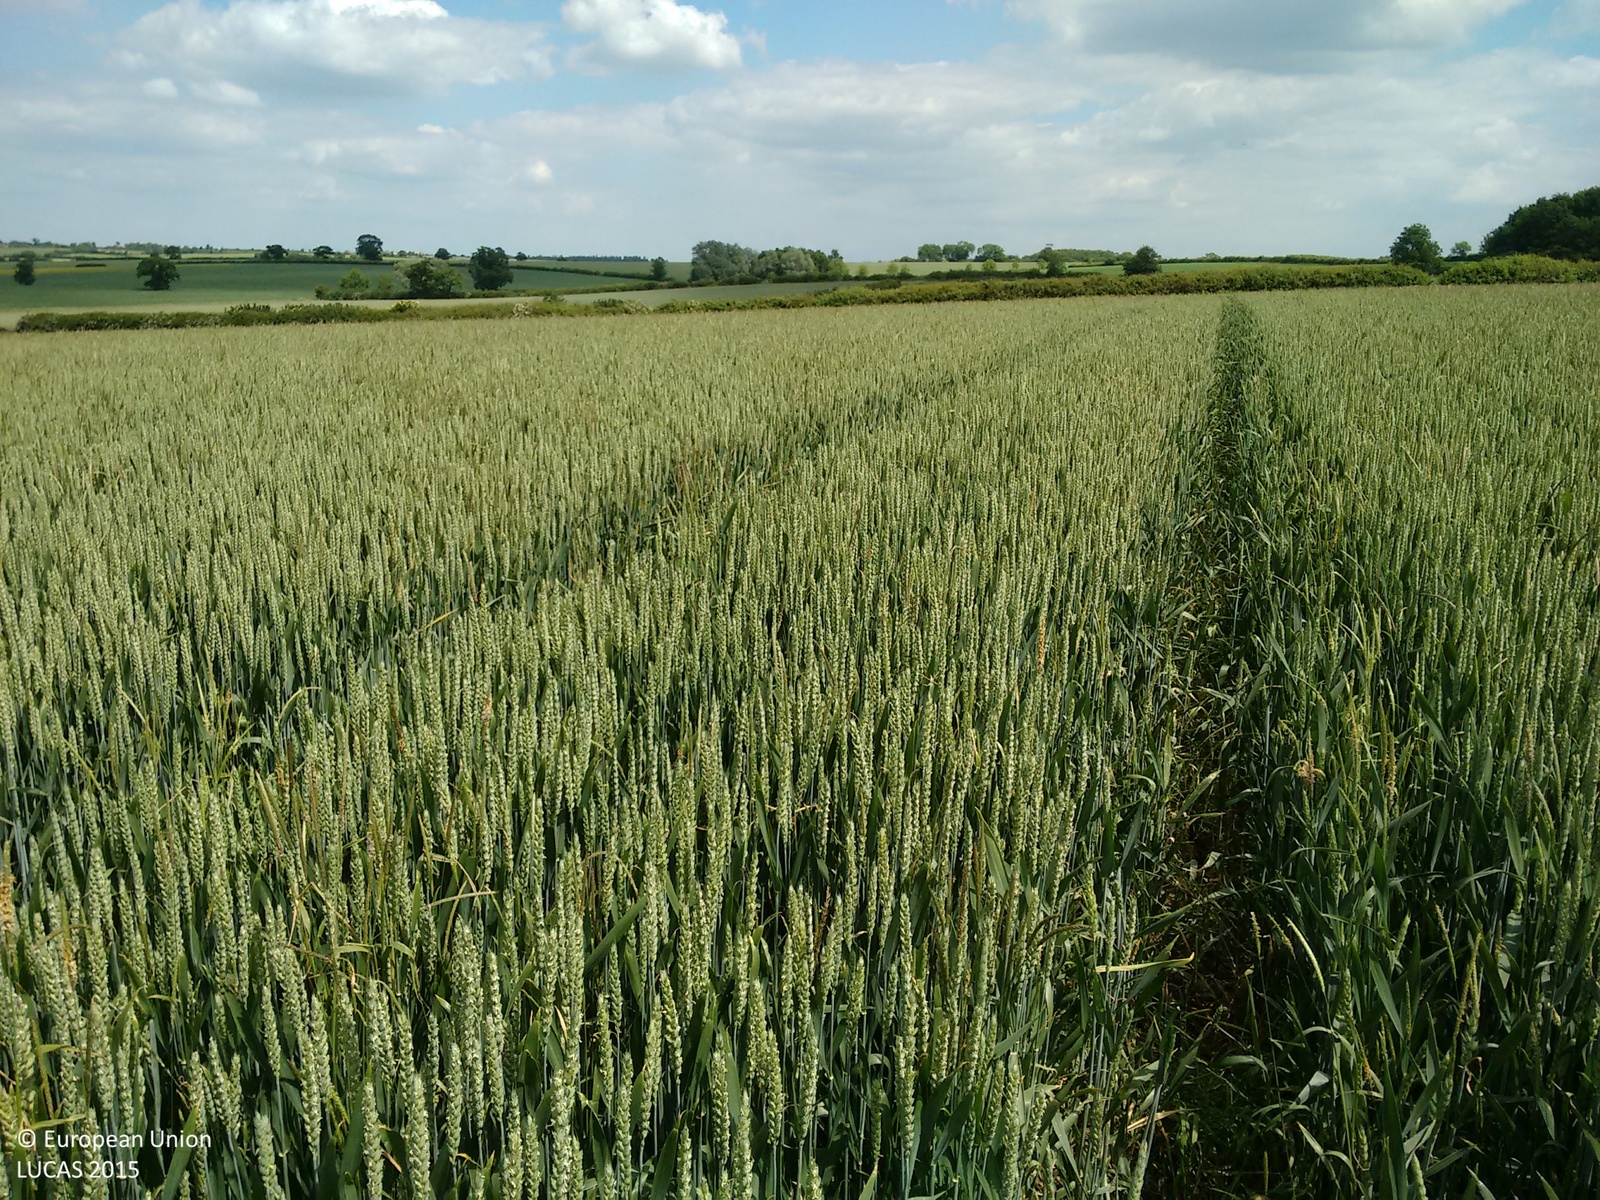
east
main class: Cropland
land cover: Common wheat
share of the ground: > 75 %
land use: Agriculture (excluding fallow land and kitchen gardens)
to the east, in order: Common wheat; Tracks; Managed hedges; Grass margins; Barley; Common wheat
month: June
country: GB
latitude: 52.0759
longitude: -0.6769
